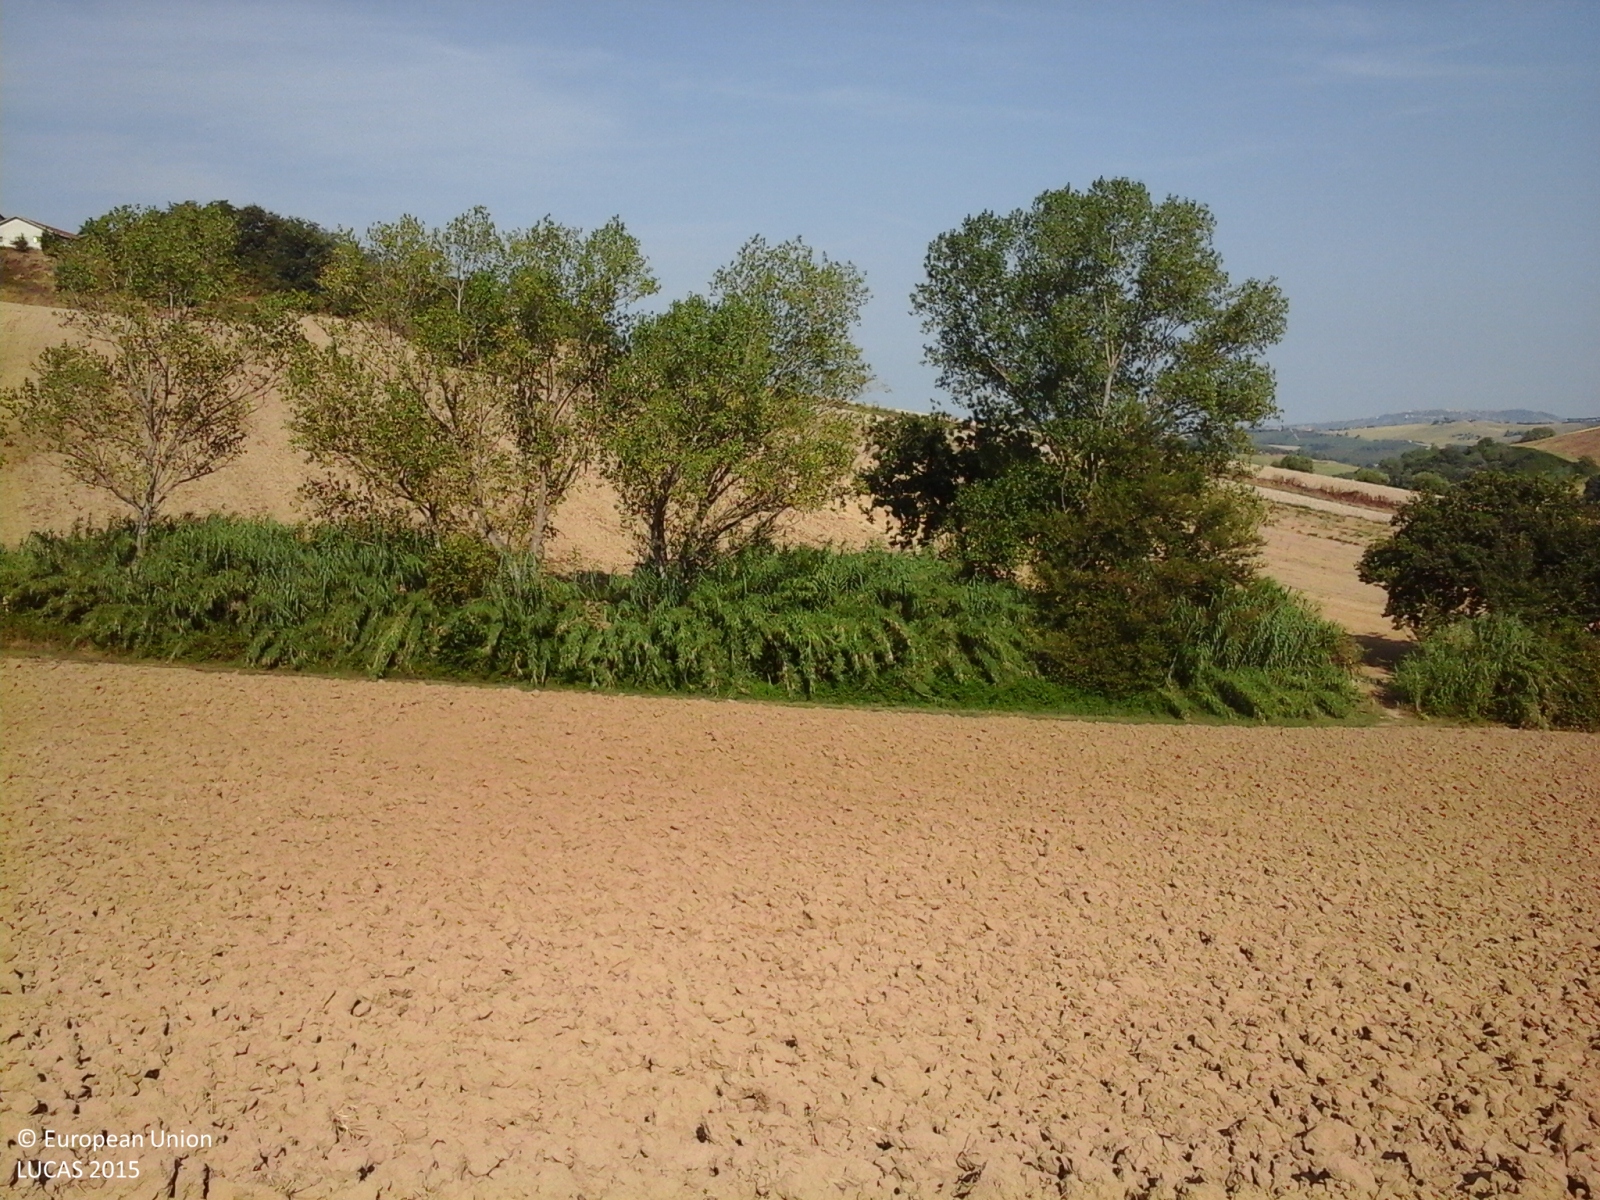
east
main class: Cropland
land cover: Durum wheat
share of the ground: < 10 %
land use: Agriculture (excluding fallow land and kitchen gardens)
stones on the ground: 10 - 25 %
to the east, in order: Durum wheat; Shruby margins; Broadleaved woodland; Dry pulses; Single bushes/trees; Dry pulses; Electric lines; Dry pulses
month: August
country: IT
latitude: 43.4466
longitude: 13.3896
